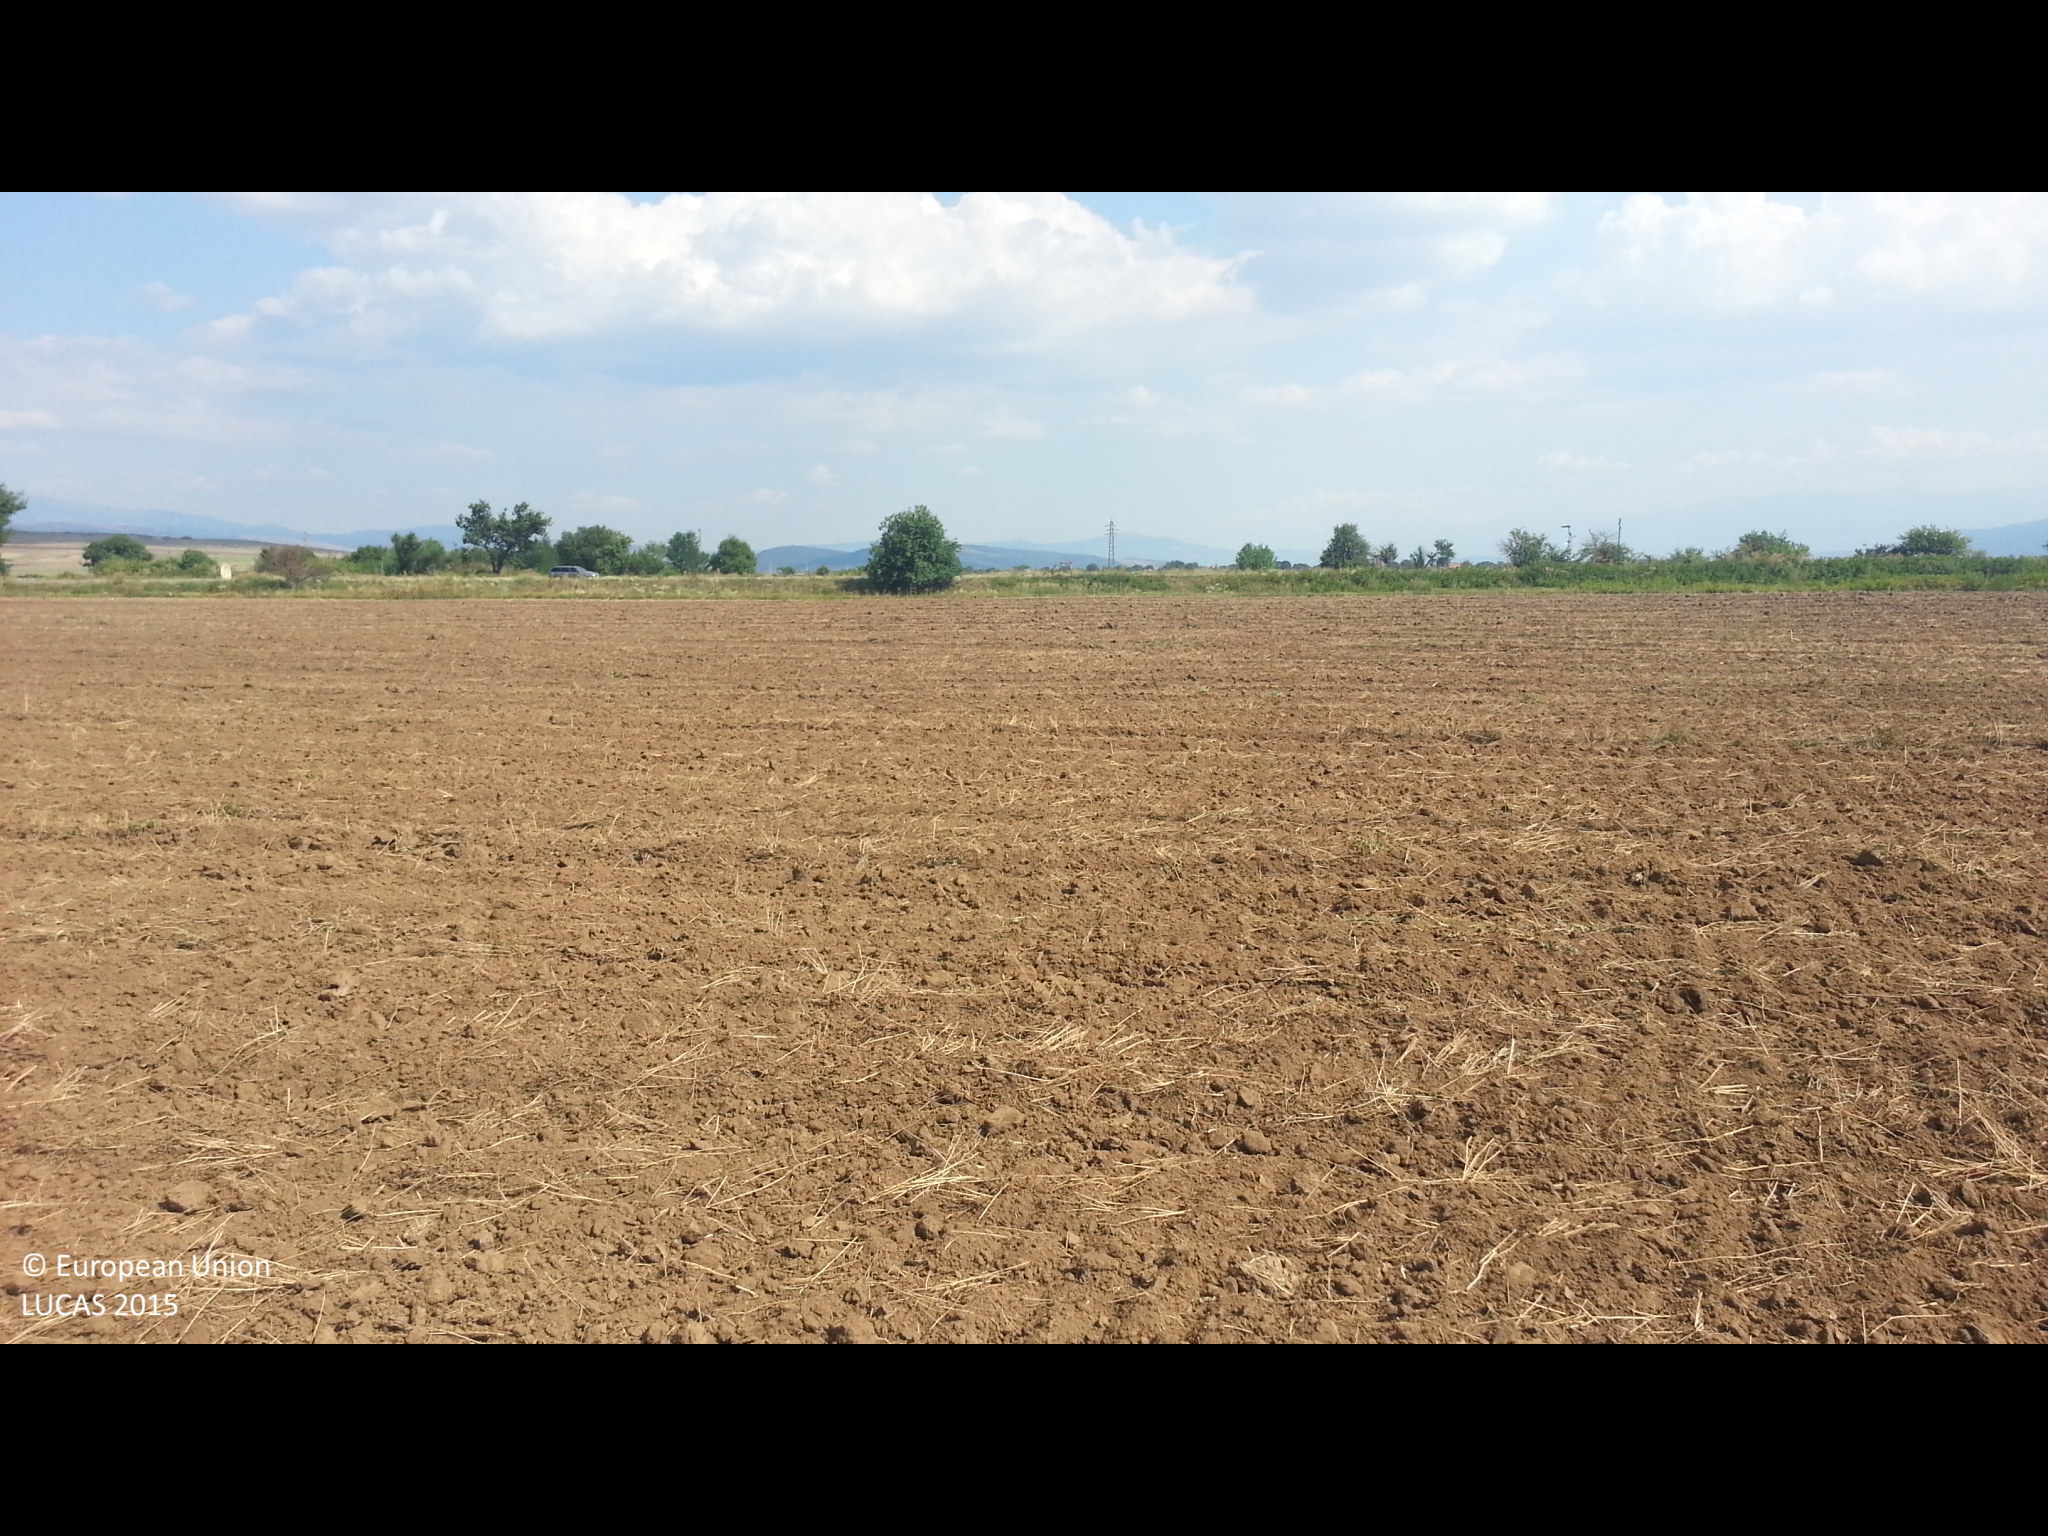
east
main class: Cropland
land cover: Common wheat
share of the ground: < 10 %
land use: Agriculture (excluding fallow land and kitchen gardens)
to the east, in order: Common wheat; Grass margins; Single bushes/trees; Grass margins; Paved roads, cycling and walking lanes; Grass margins; Tracks; Shrubland with sparse tree cover; Railways; Grass margins; Tracks; Shrubland with sparse tree cover
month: August
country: BG
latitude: 42.4963
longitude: 22.9370
